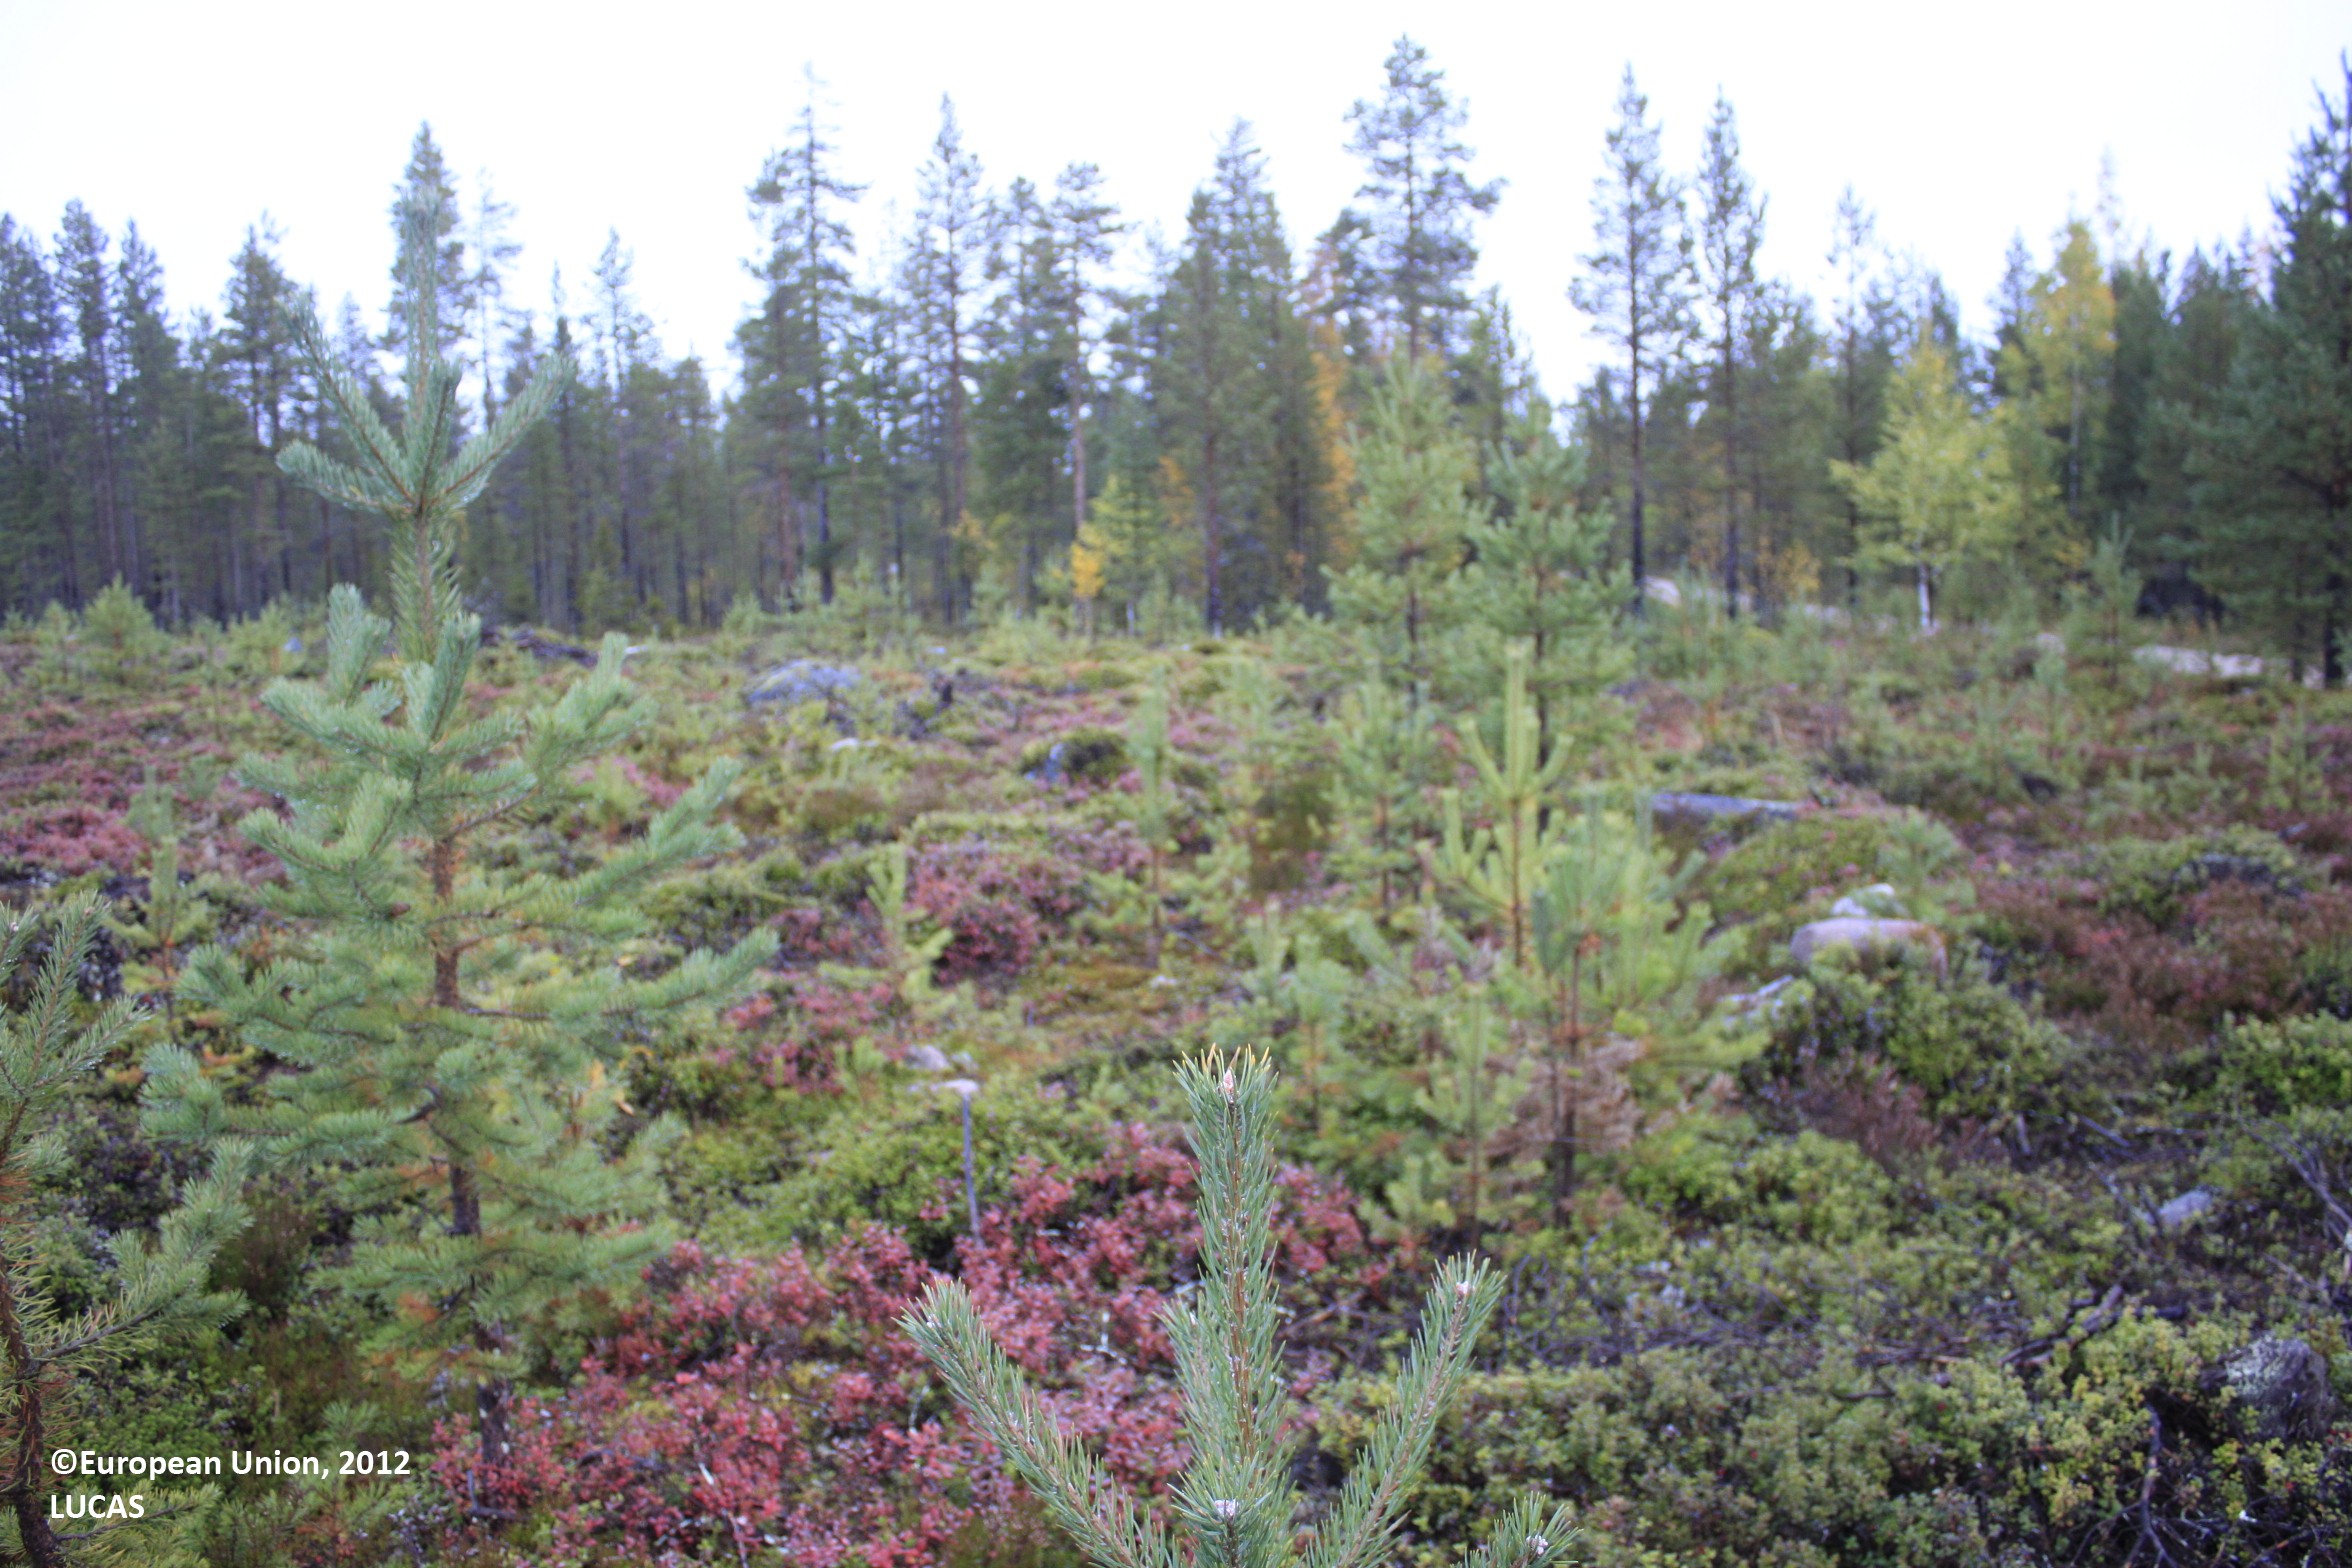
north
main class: Woodland
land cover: Pine dominated coniferous woodland
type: boreal forest
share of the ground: 10 - 25 %
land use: Forestry
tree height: < 5 m
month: September
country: FI
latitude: 66.0205
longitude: 26.7943
